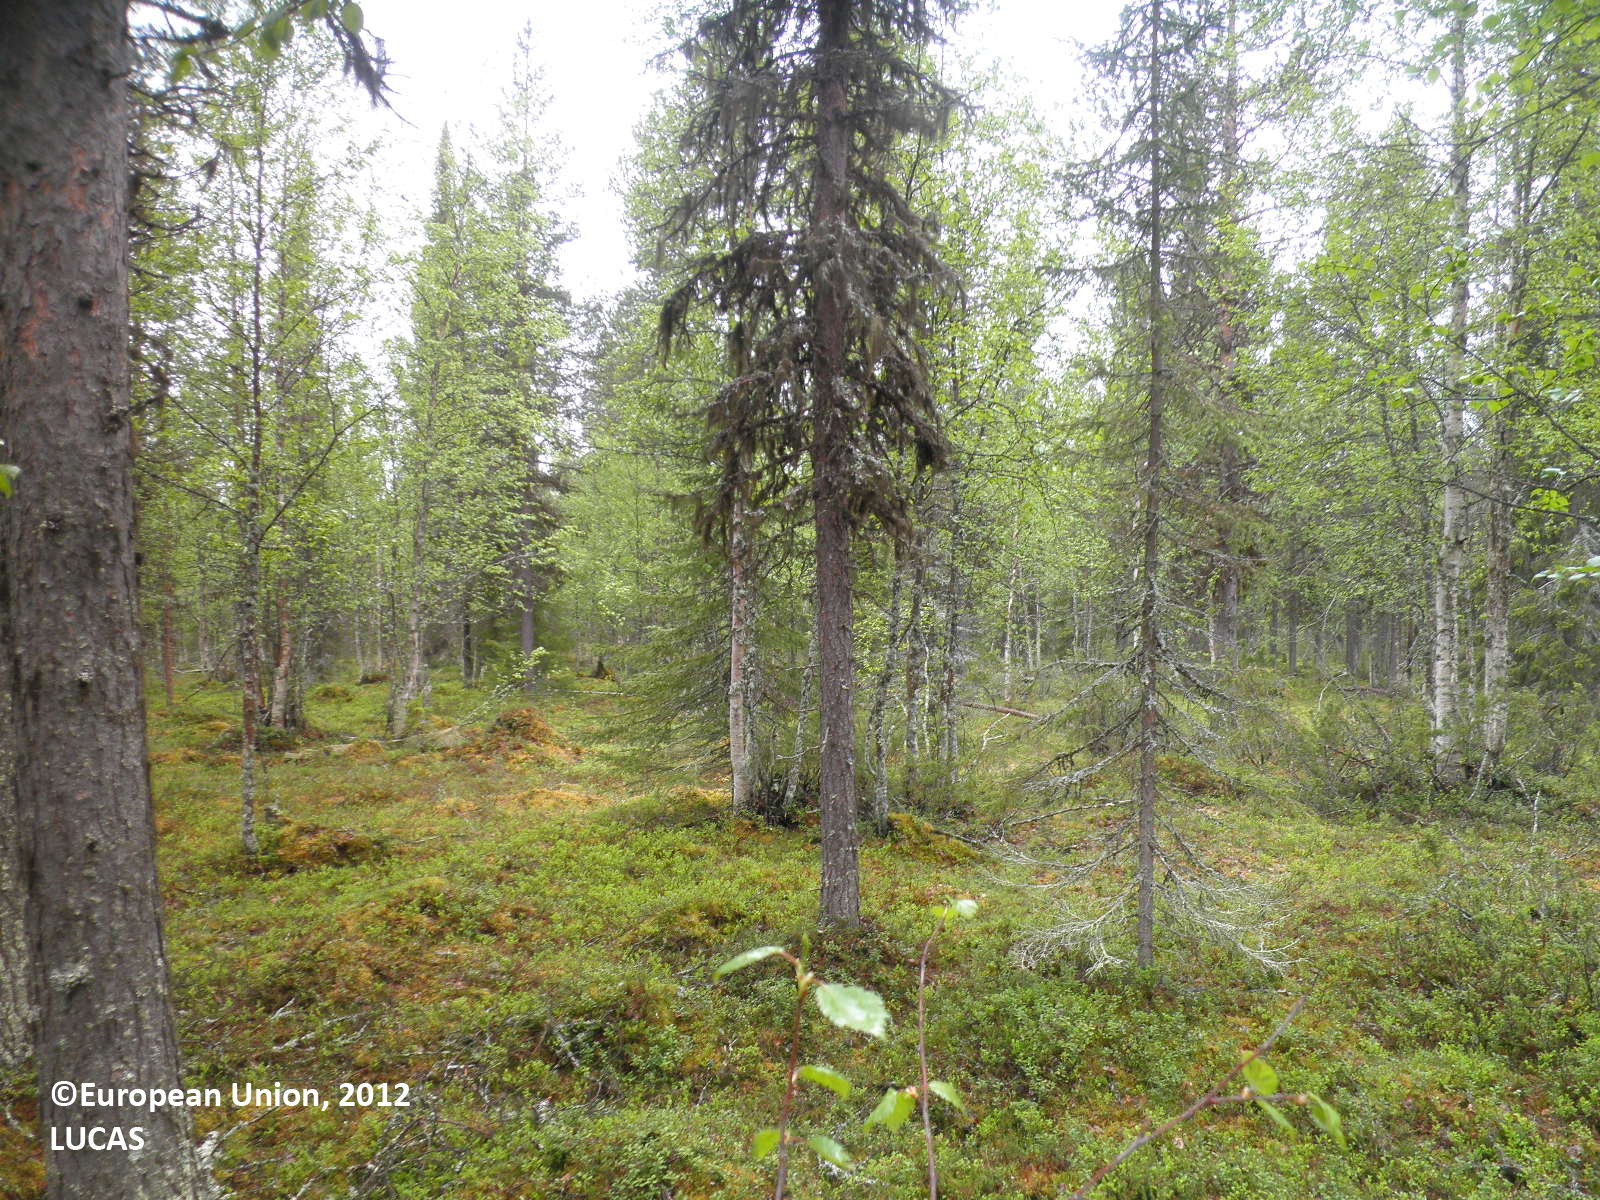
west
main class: Woodland
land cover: Pine dominated mixed woodland
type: boreal forest
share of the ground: > 75 %
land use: Forestry
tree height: > 5 m
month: June
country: FI
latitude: 68.0839
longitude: 25.4274
